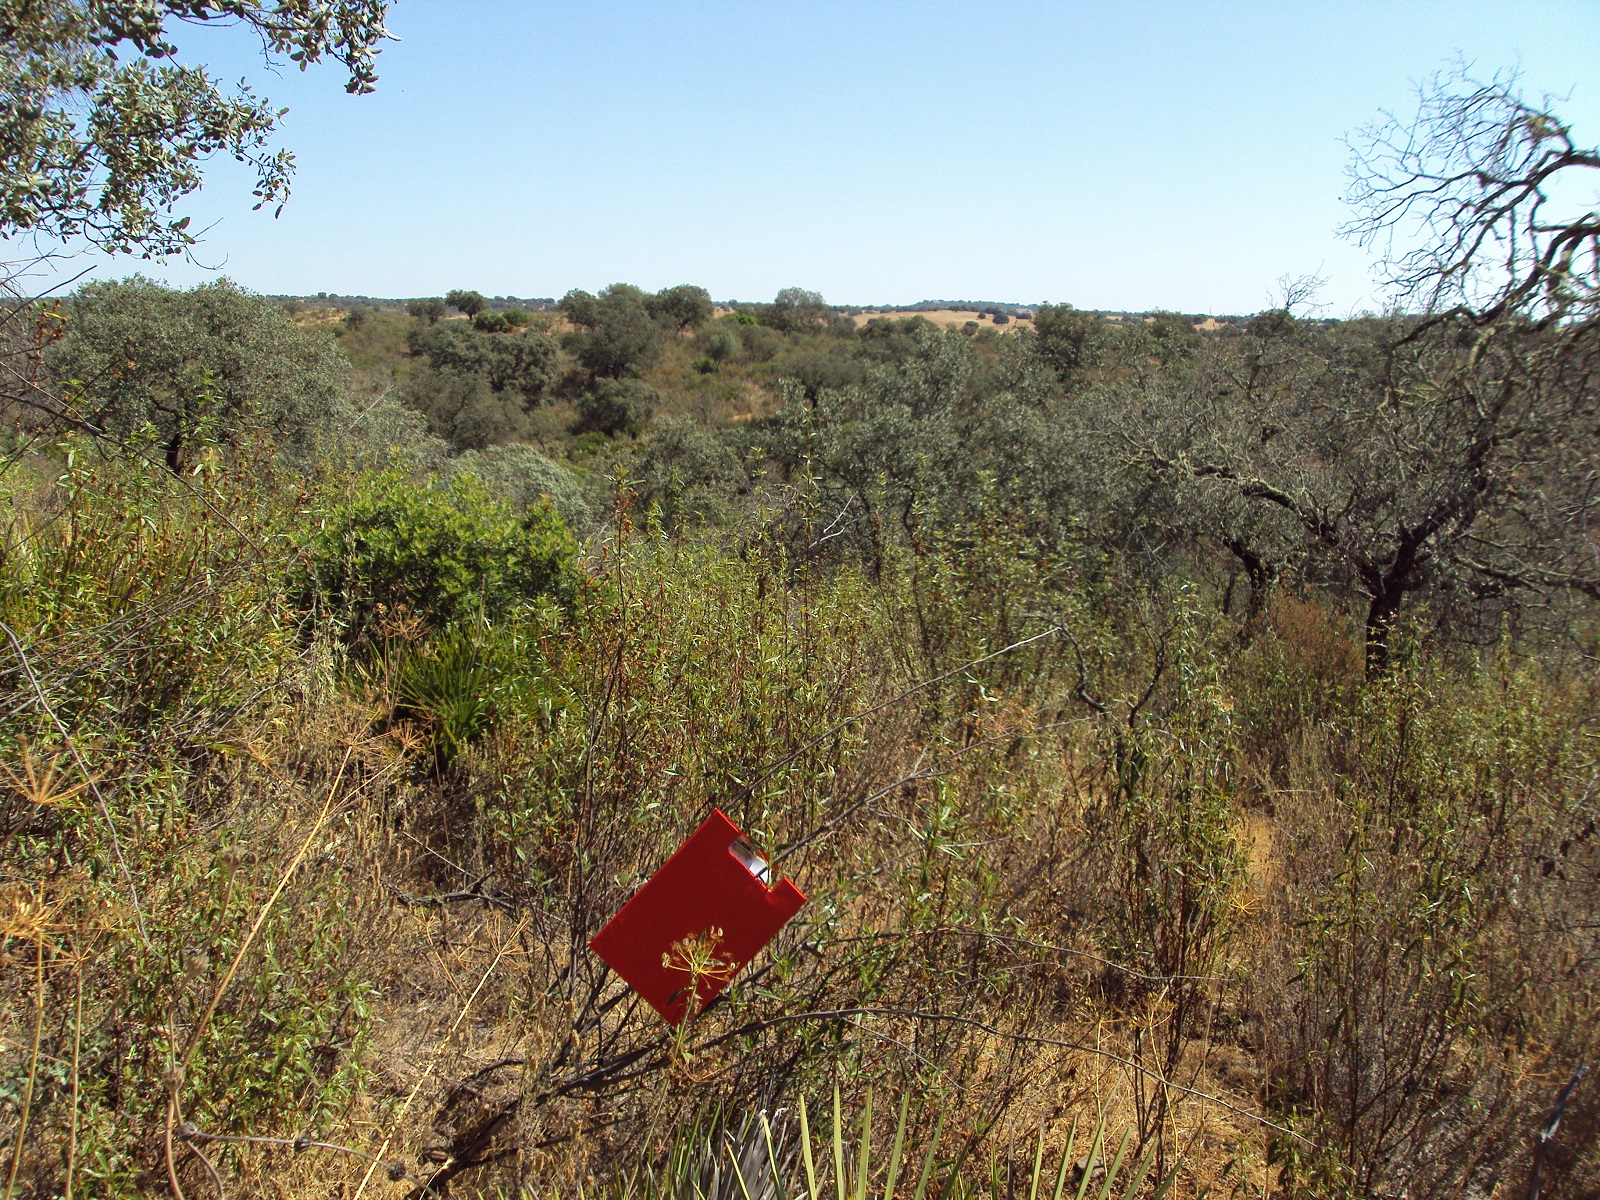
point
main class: Woodland
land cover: Broadleaved woodland
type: broadleaved evergreen forest
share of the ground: 25 - 50 %
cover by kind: shrubs 70 %, broadleaved forest trees 30 %
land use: Semi-natural and natural areas not in use
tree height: < 5 m
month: June
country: ES
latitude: 37.4217
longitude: -6.9113
